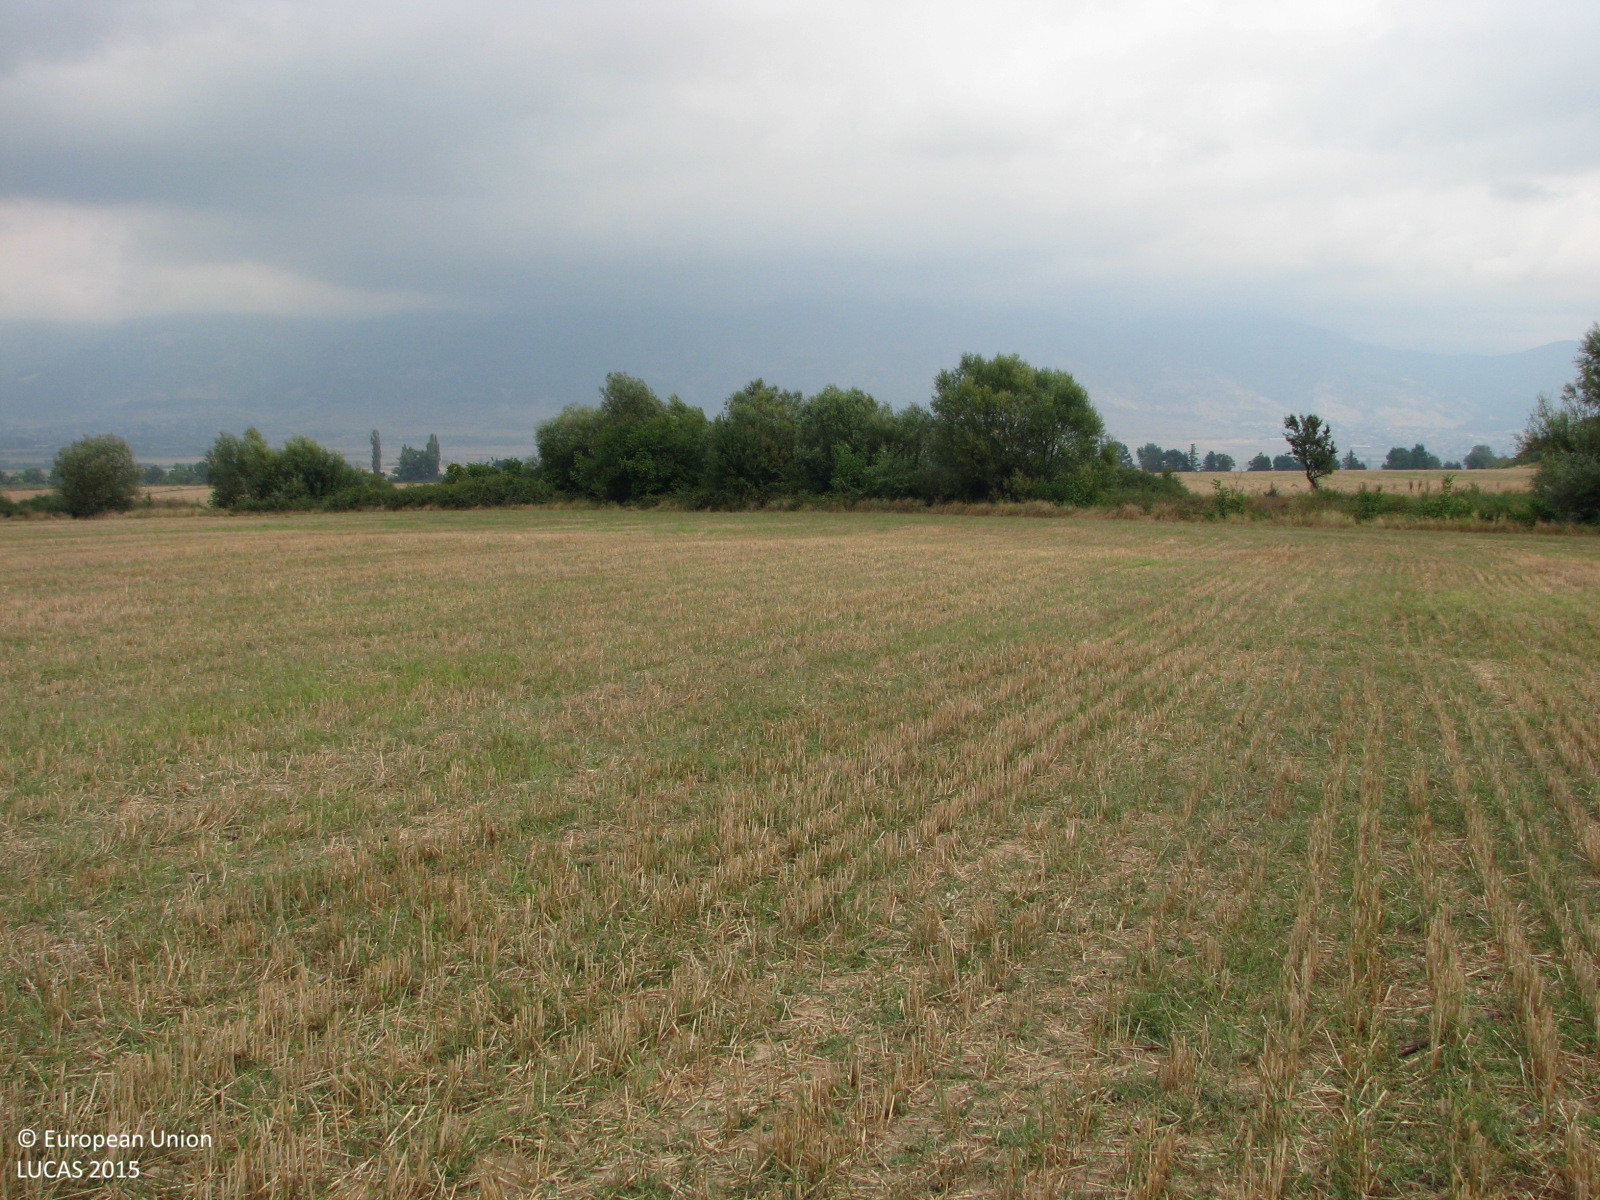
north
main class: Cropland
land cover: Common wheat
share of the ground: 25 - 50 %
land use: Agriculture (excluding fallow land and kitchen gardens)
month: August
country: BG
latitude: 42.6405
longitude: 25.9981
